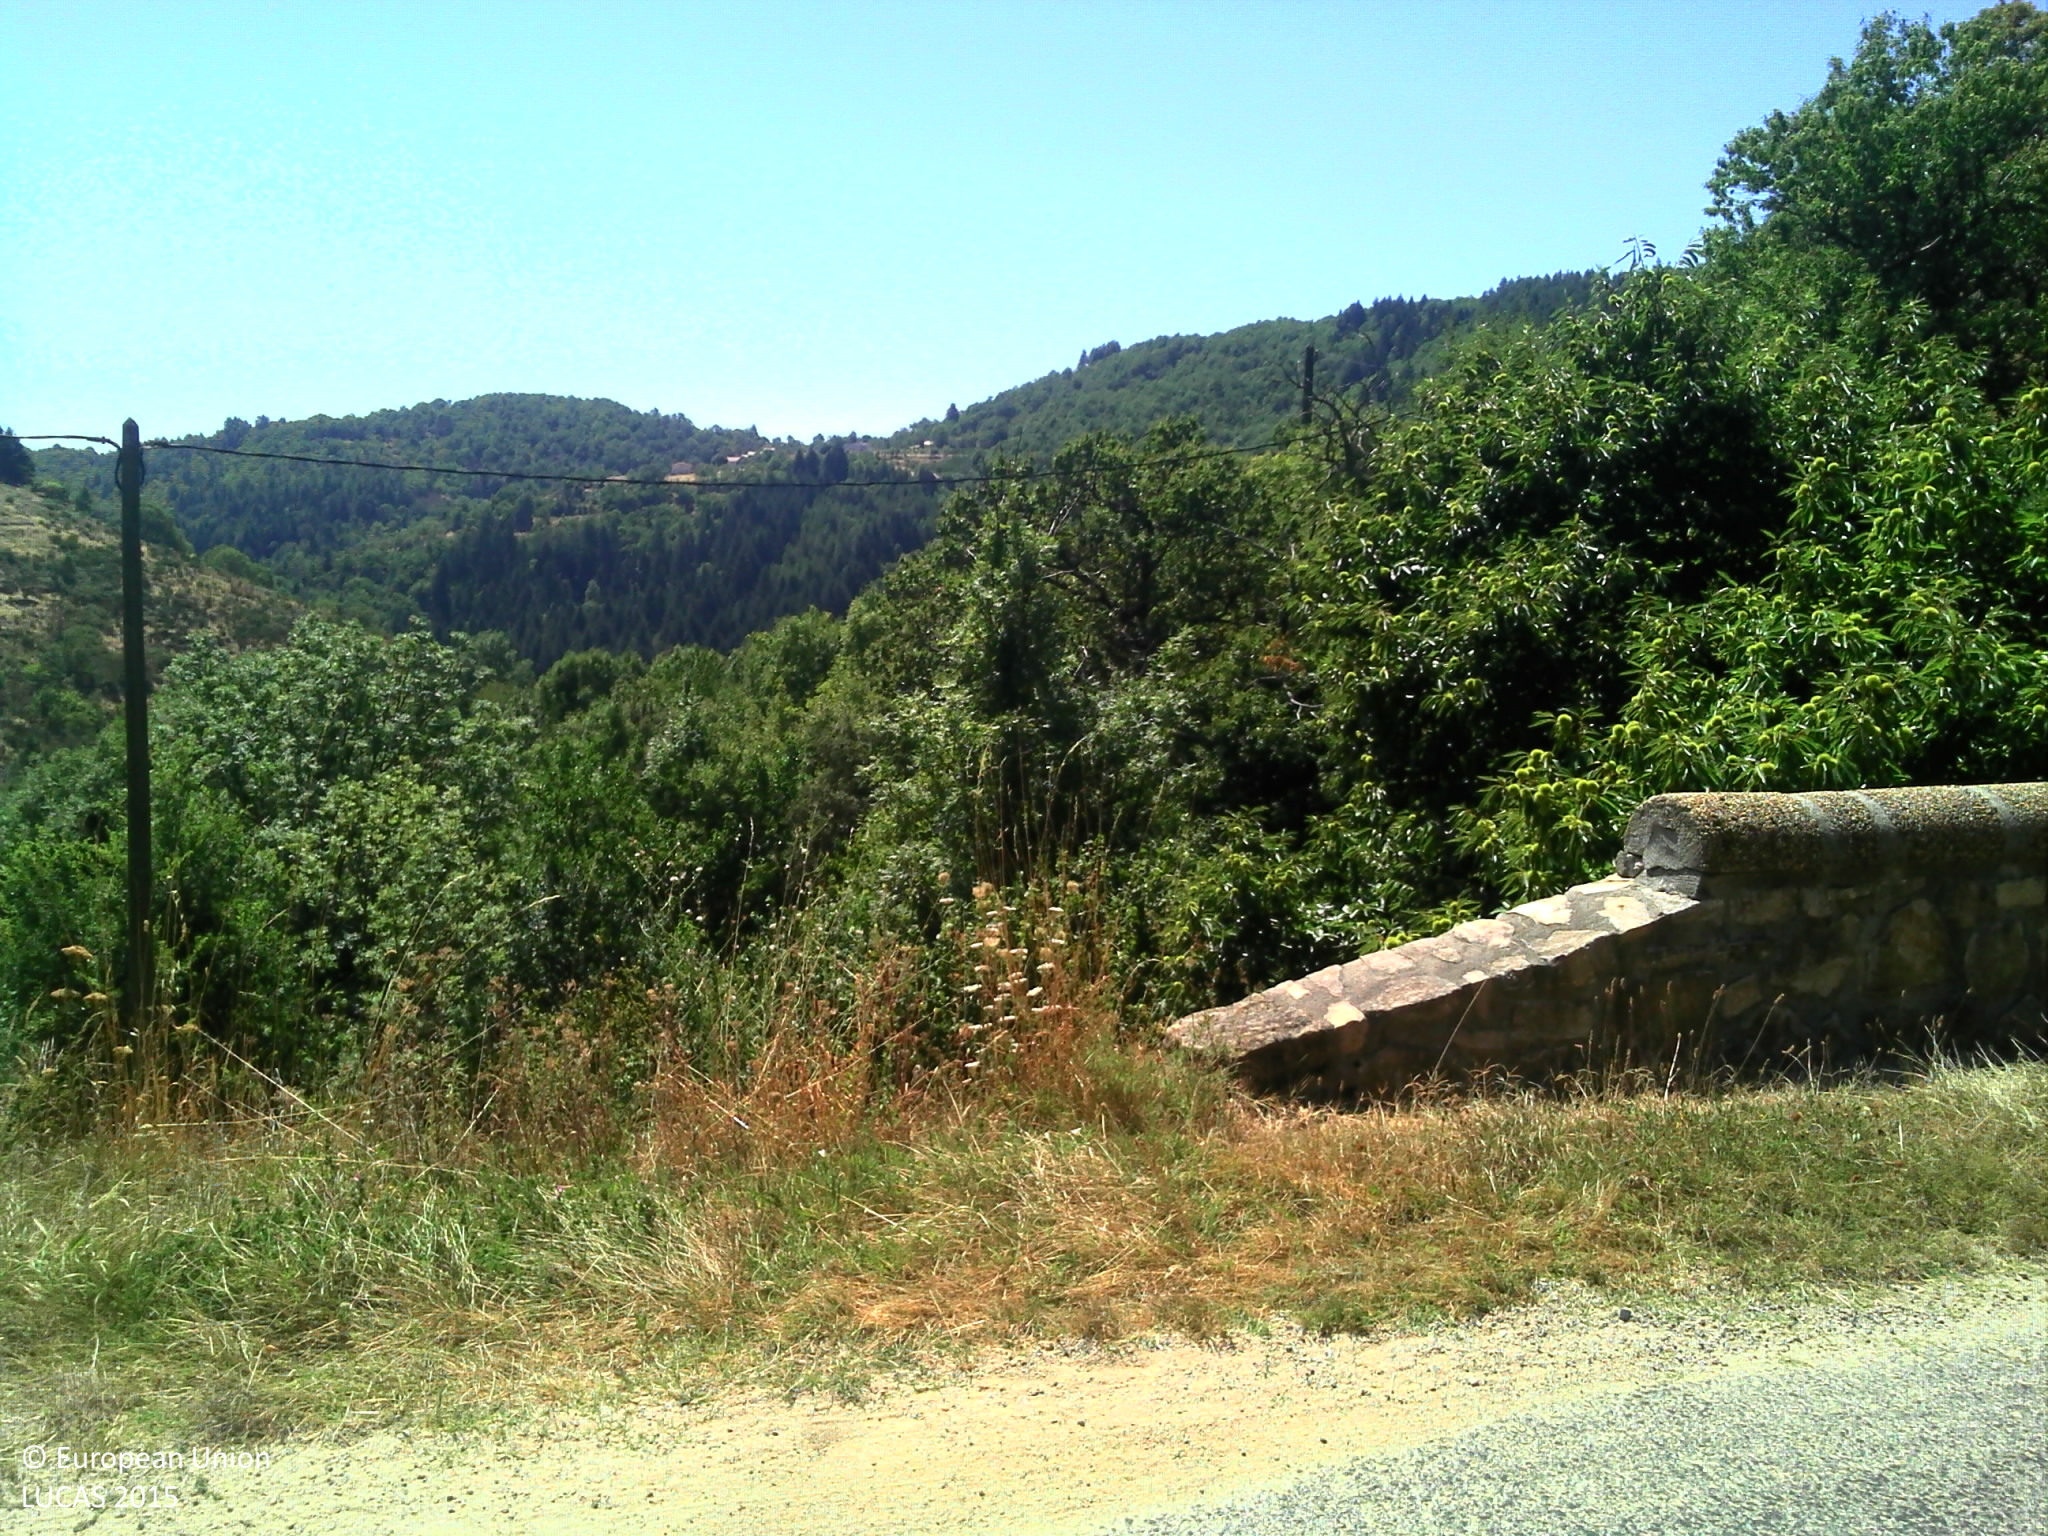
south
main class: Grassland
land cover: Grassland without tree/shrub cover
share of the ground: > 75 %
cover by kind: herbaceous plants 100 %
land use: Semi-natural and natural areas not in use
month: September
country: FR
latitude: 44.6095
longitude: 4.2981
